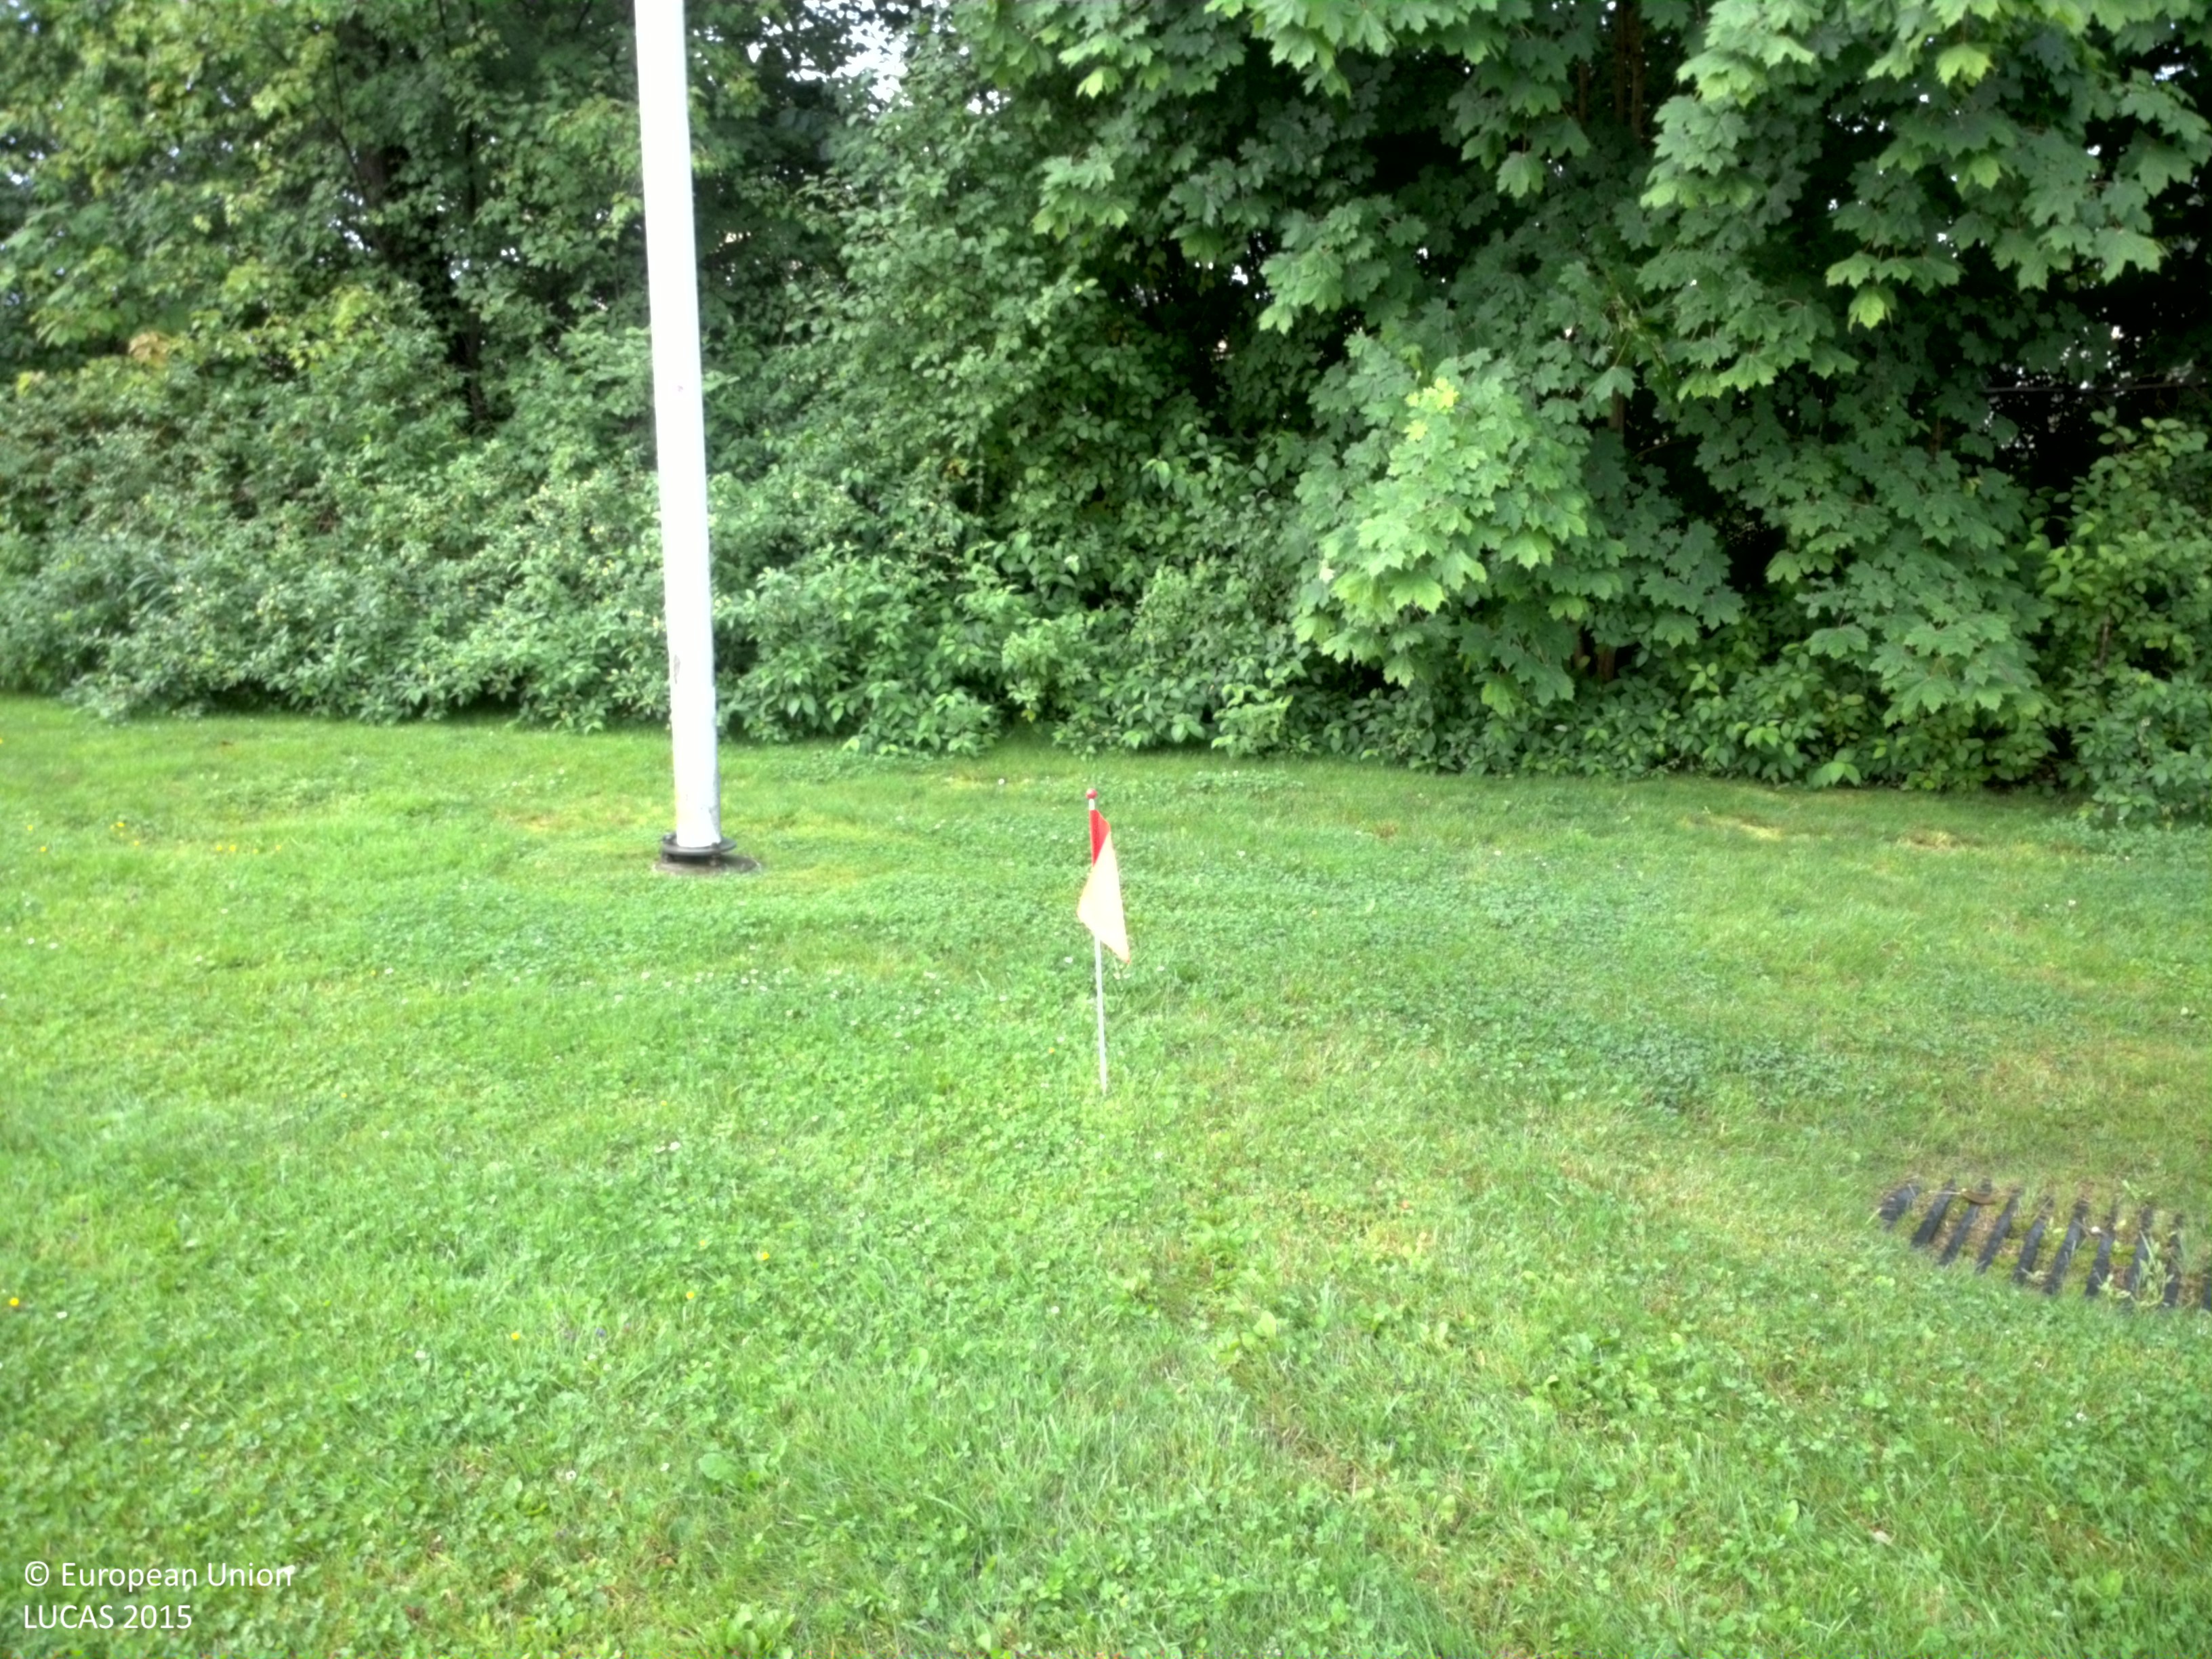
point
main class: Grassland
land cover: Grassland without tree/shrub cover
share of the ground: > 75 %
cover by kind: herbaceous plants 90 %
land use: Commerce
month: July
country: SE
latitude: 59.3816
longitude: 13.4599
